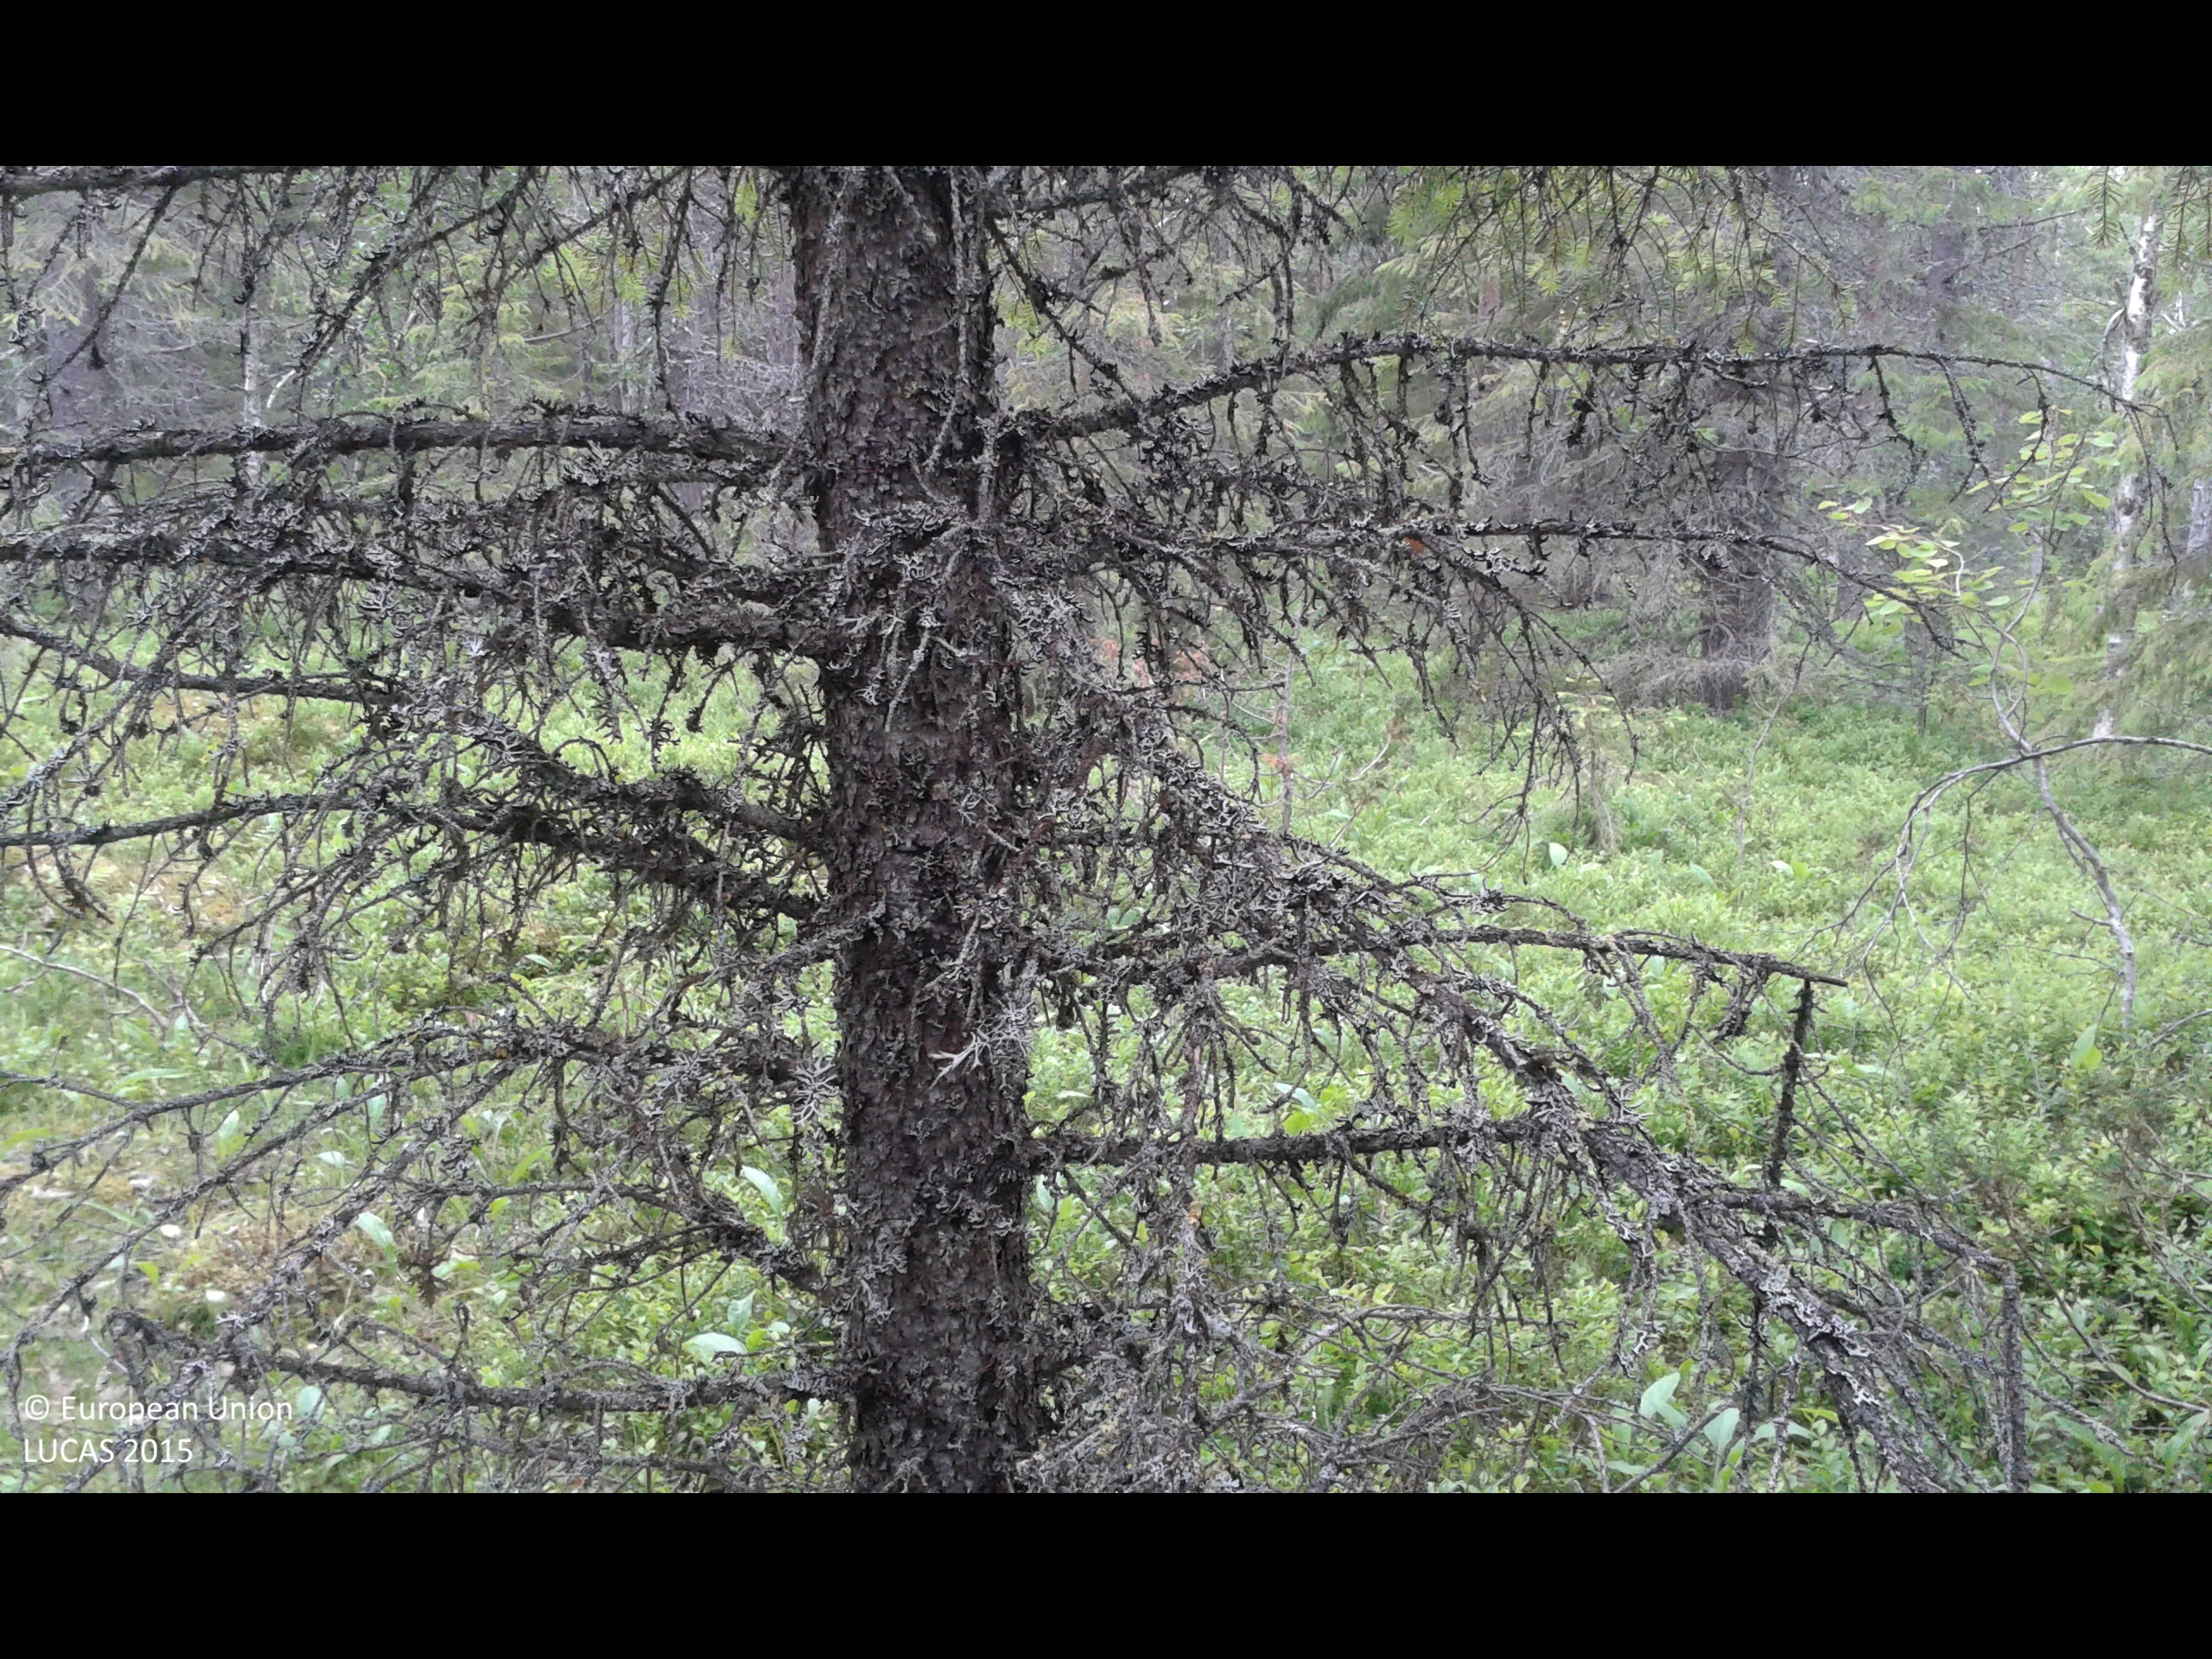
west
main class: Woodland
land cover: Spruce dominated mixed woodland
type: boreal forest
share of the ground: 25 - 50 %
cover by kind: shrubs 45 %, coniferous forest trees 30 %, herbaceous plants 15 %, broadleaved forest trees 10 %
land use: Forestry
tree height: > 5 m
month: July
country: SE
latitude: 66.7634
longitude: 23.4950
